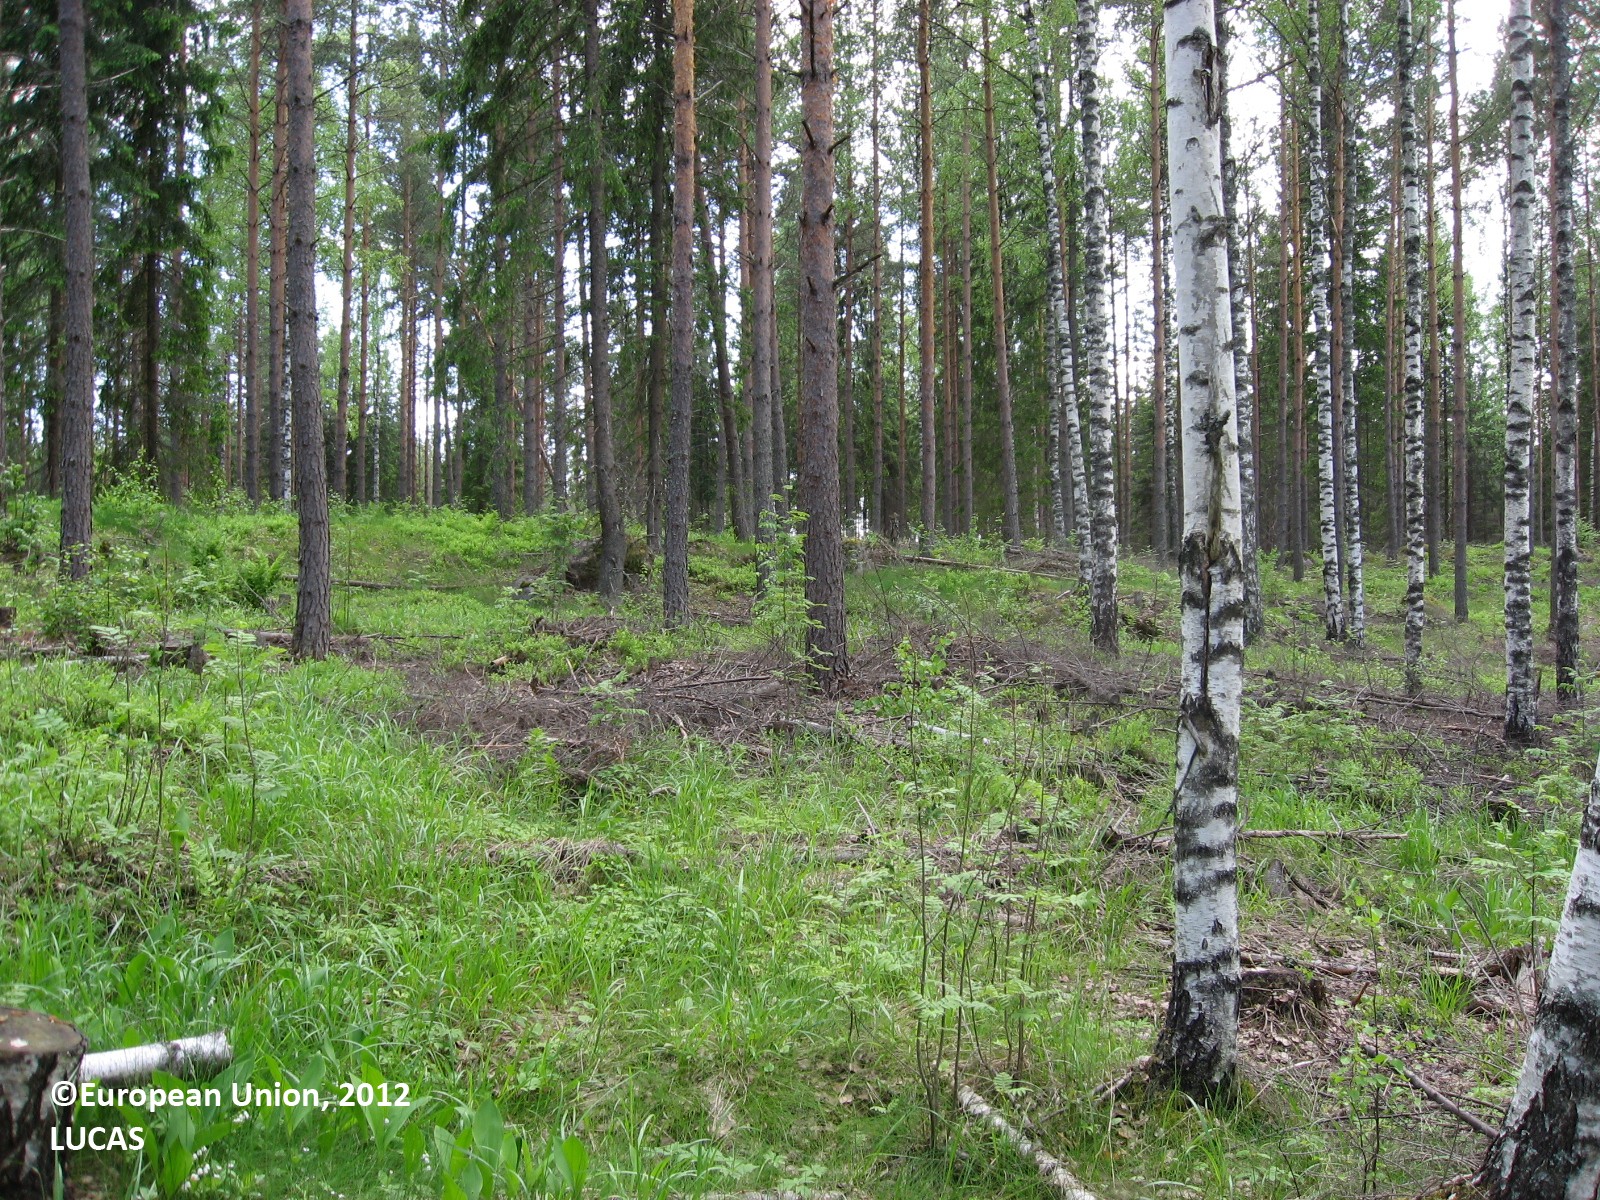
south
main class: Woodland
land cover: Other mixed woodland
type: boreal forest
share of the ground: > 75 %
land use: Forestry
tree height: > 5 m
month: June
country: FI
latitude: 60.4131
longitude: 25.3975
